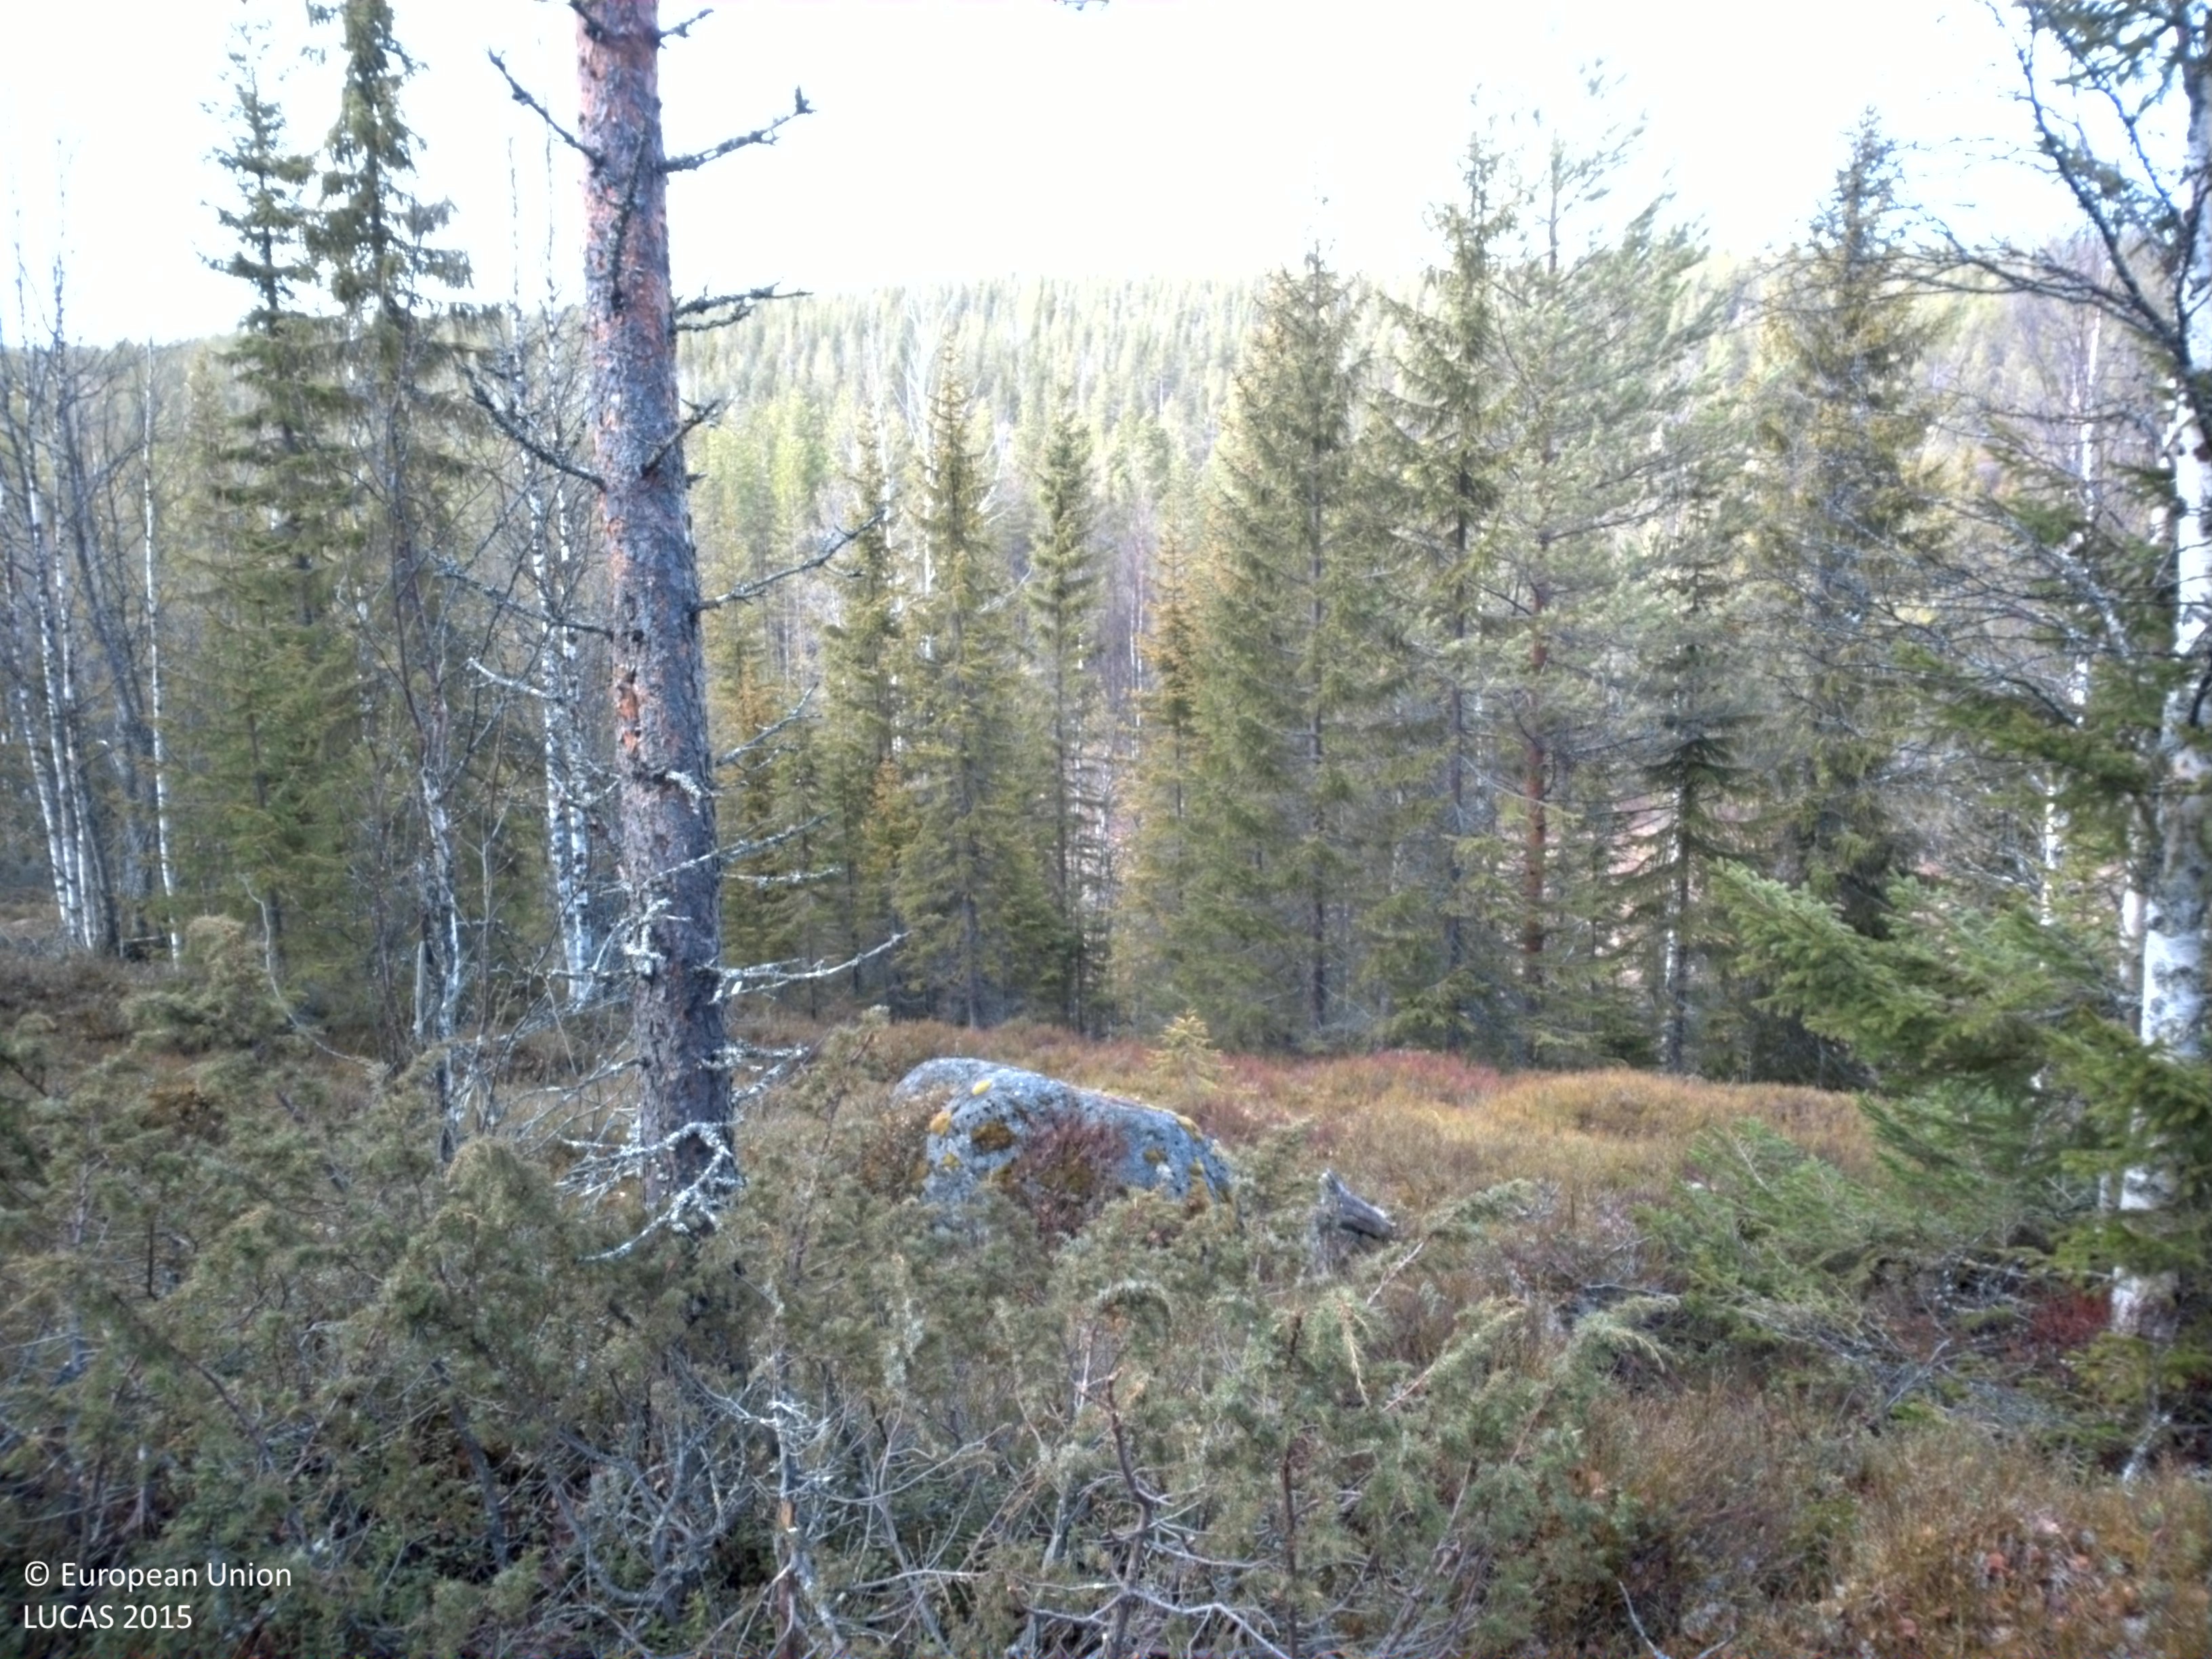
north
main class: Woodland
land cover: Spruce dominated coniferous woodland
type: boreal forest
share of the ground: 10 - 25 %
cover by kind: herbaceous plants 45 %, coniferous forest trees 25 %, shrubs 15 %, lichens and mosses 10 %, broadleaved forest trees 5 %
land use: Forestry
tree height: > 5 m
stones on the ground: 10 - 25 %
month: May
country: SE
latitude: 64.1952
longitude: 18.0203
